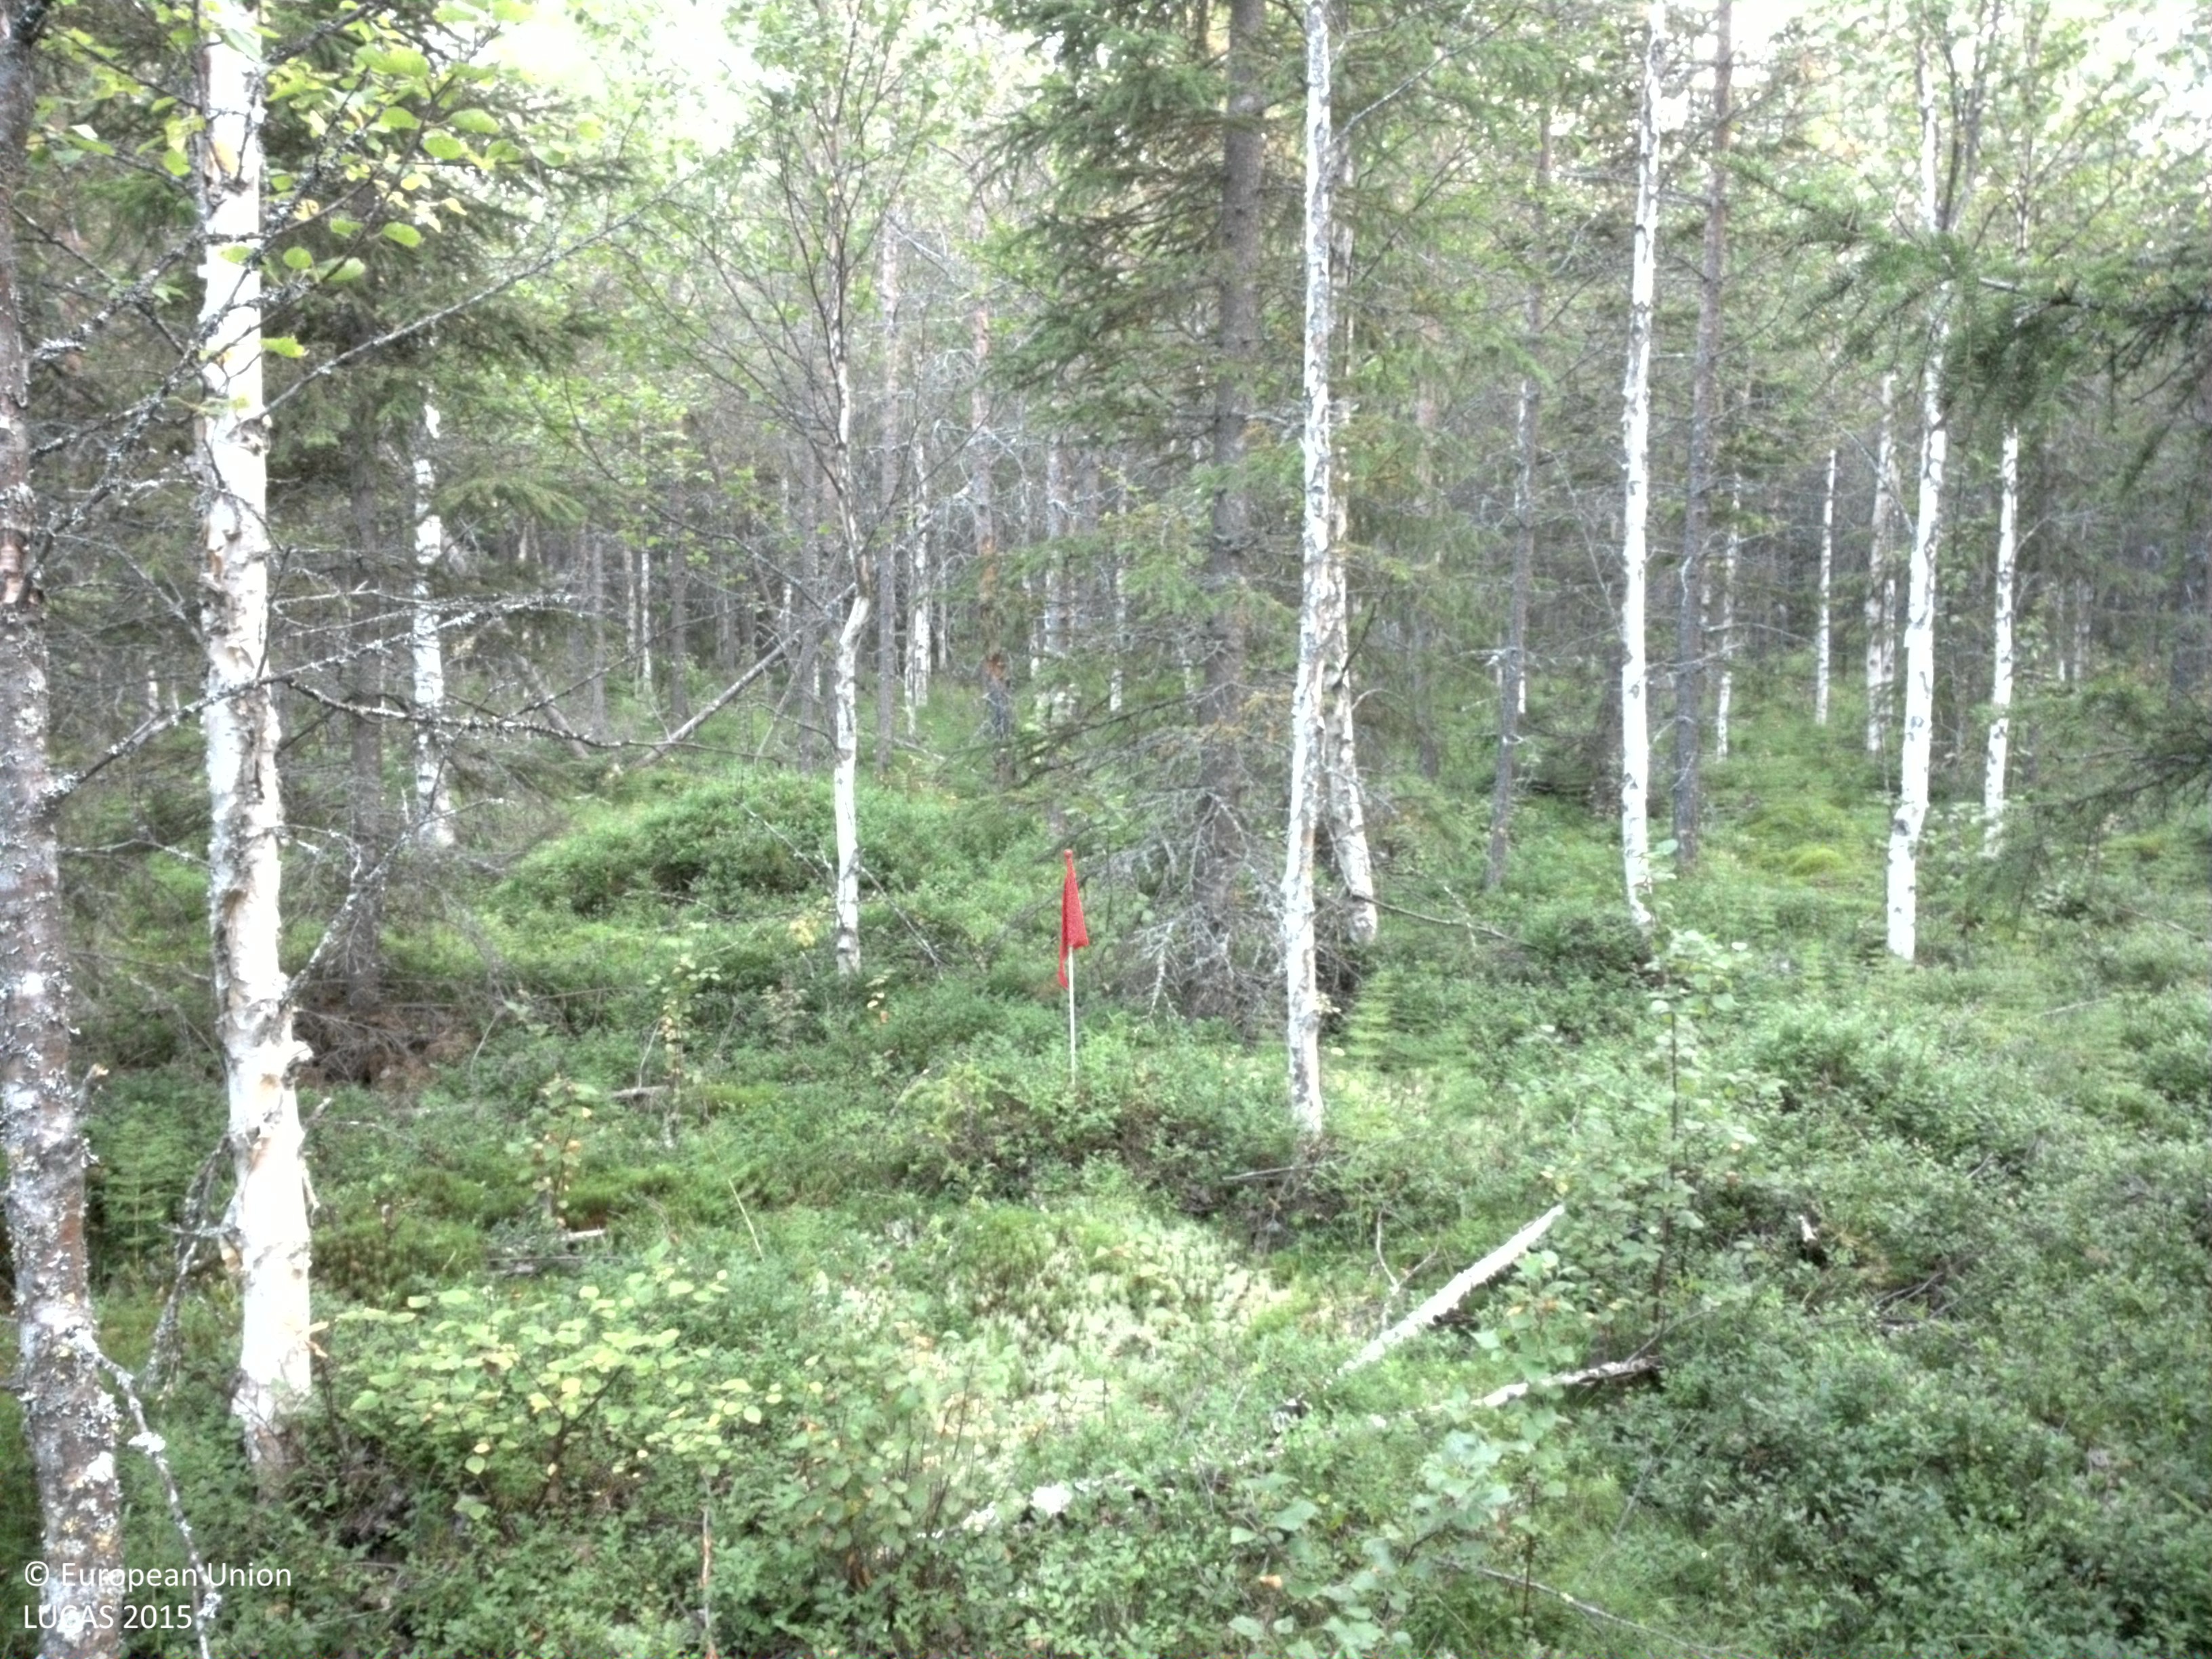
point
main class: Woodland
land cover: Spruce dominated mixed woodland
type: boreal forest
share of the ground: 50 - 75 %
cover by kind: coniferous forest trees 45 %, shrubs 30 %, broadleaved forest trees 15 %, lichens and mosses 10 %
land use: Forestry
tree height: > 5 m
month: August
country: SE
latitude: 64.3732
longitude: 18.7771
